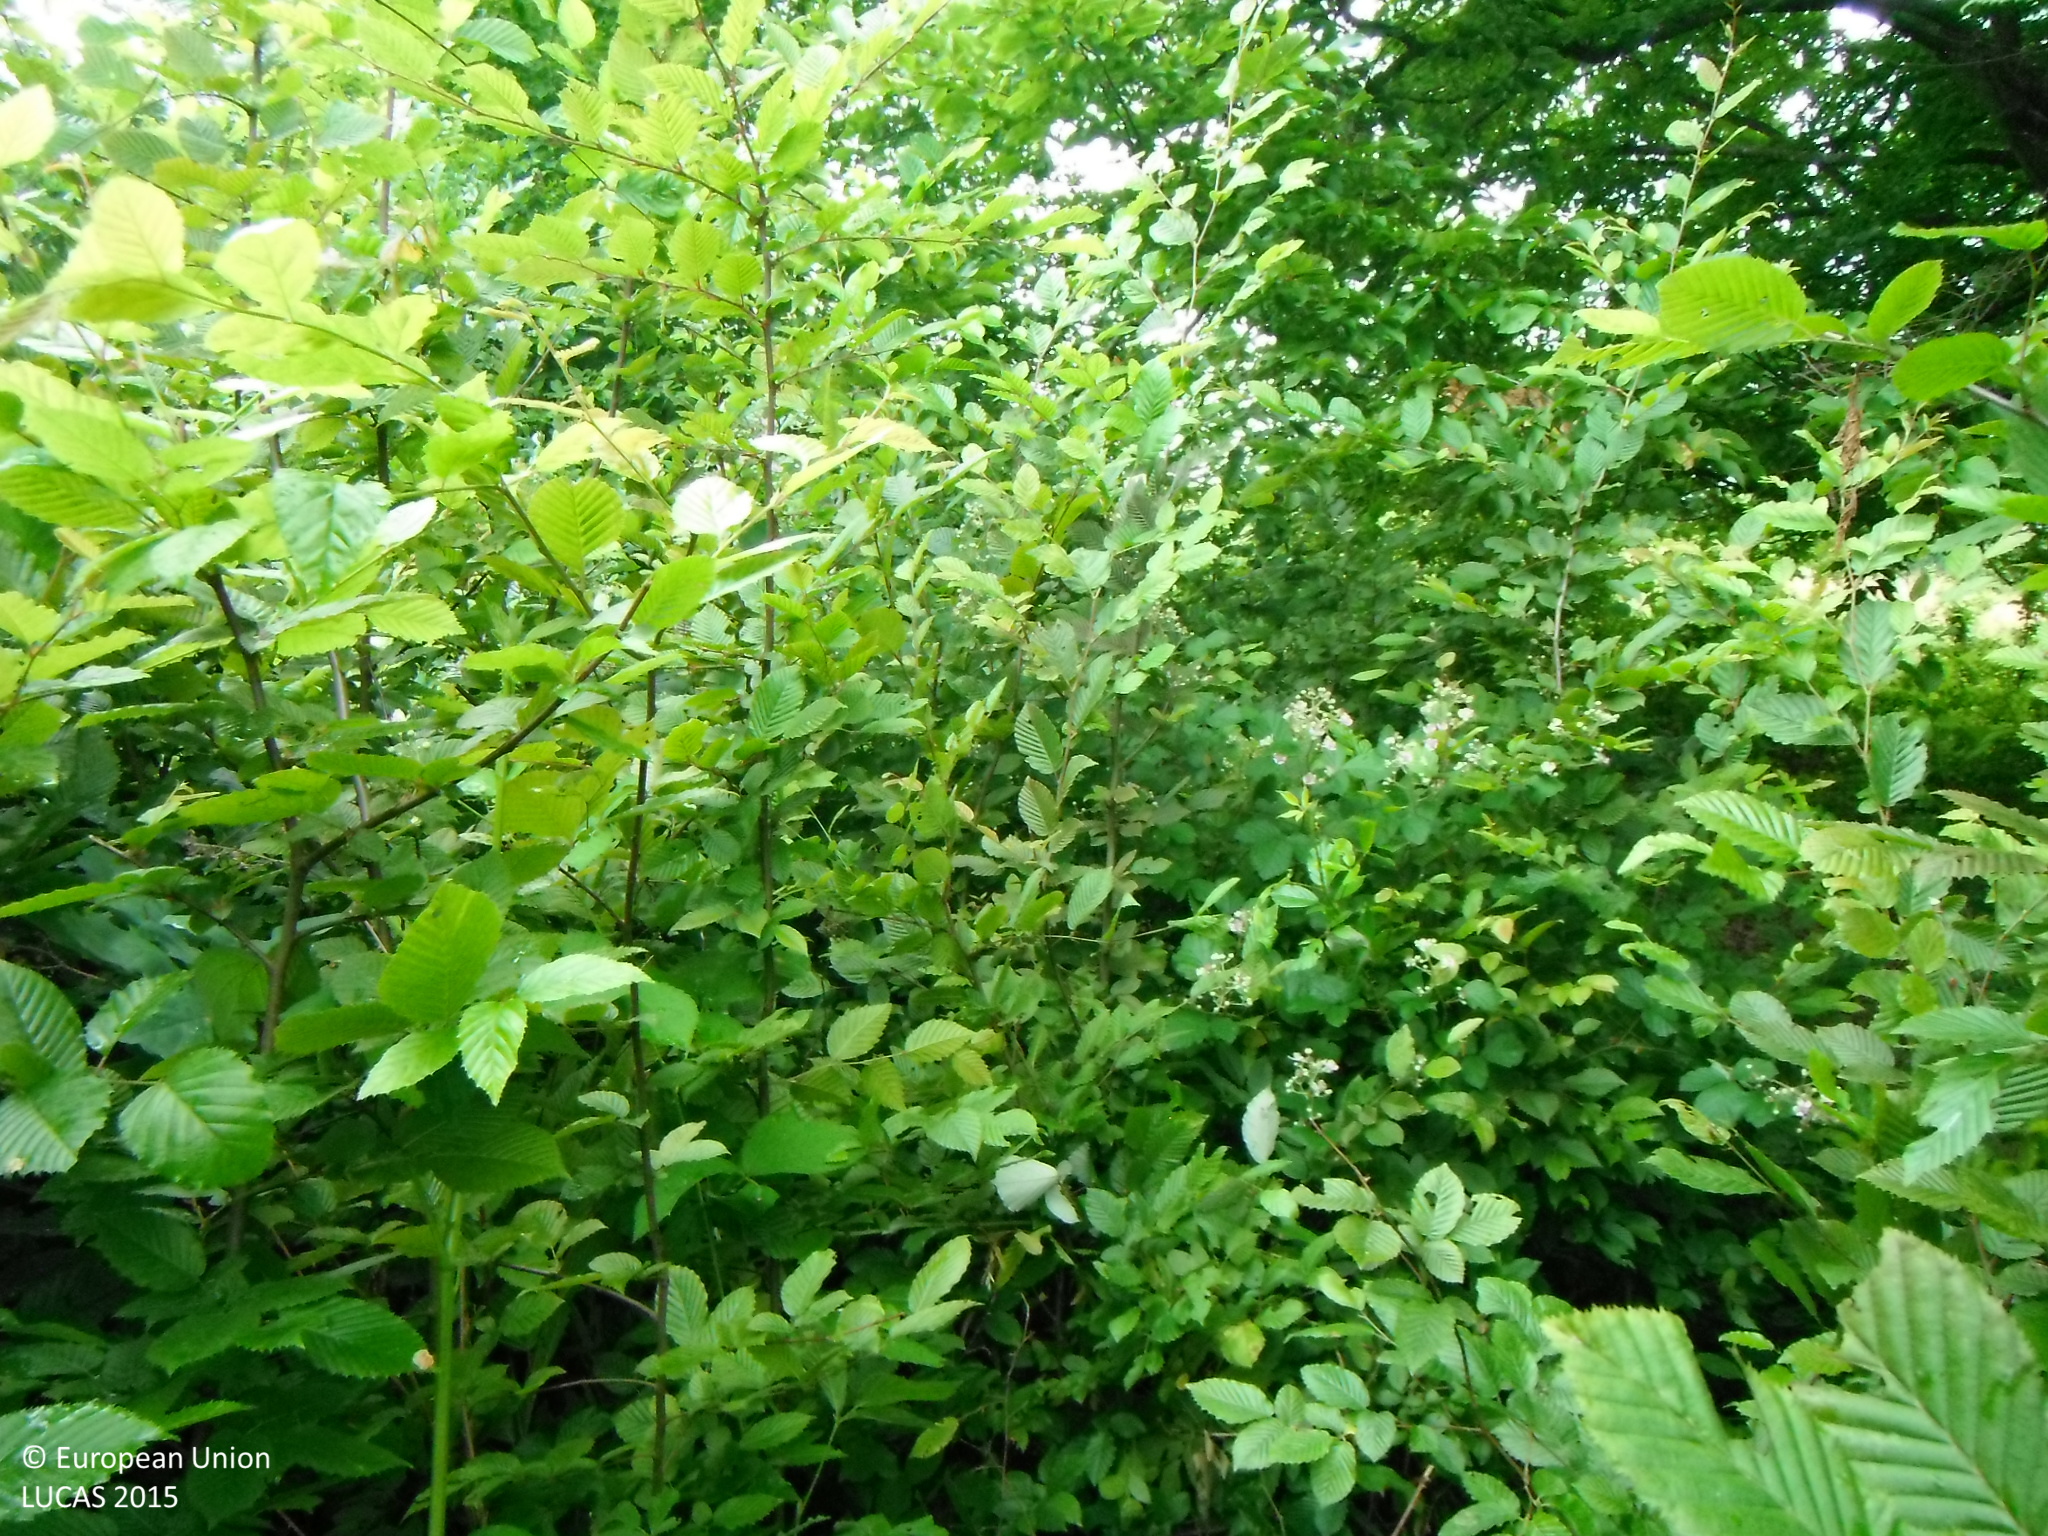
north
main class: Shrubland
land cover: Shrubland with sparse tree cover
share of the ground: > 75 %
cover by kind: shrubs 95 %, broadleaved forest trees 5 %
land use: Semi-natural and natural areas not in use
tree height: > 5 m
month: June
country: SK
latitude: 48.4522
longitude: 20.0490
